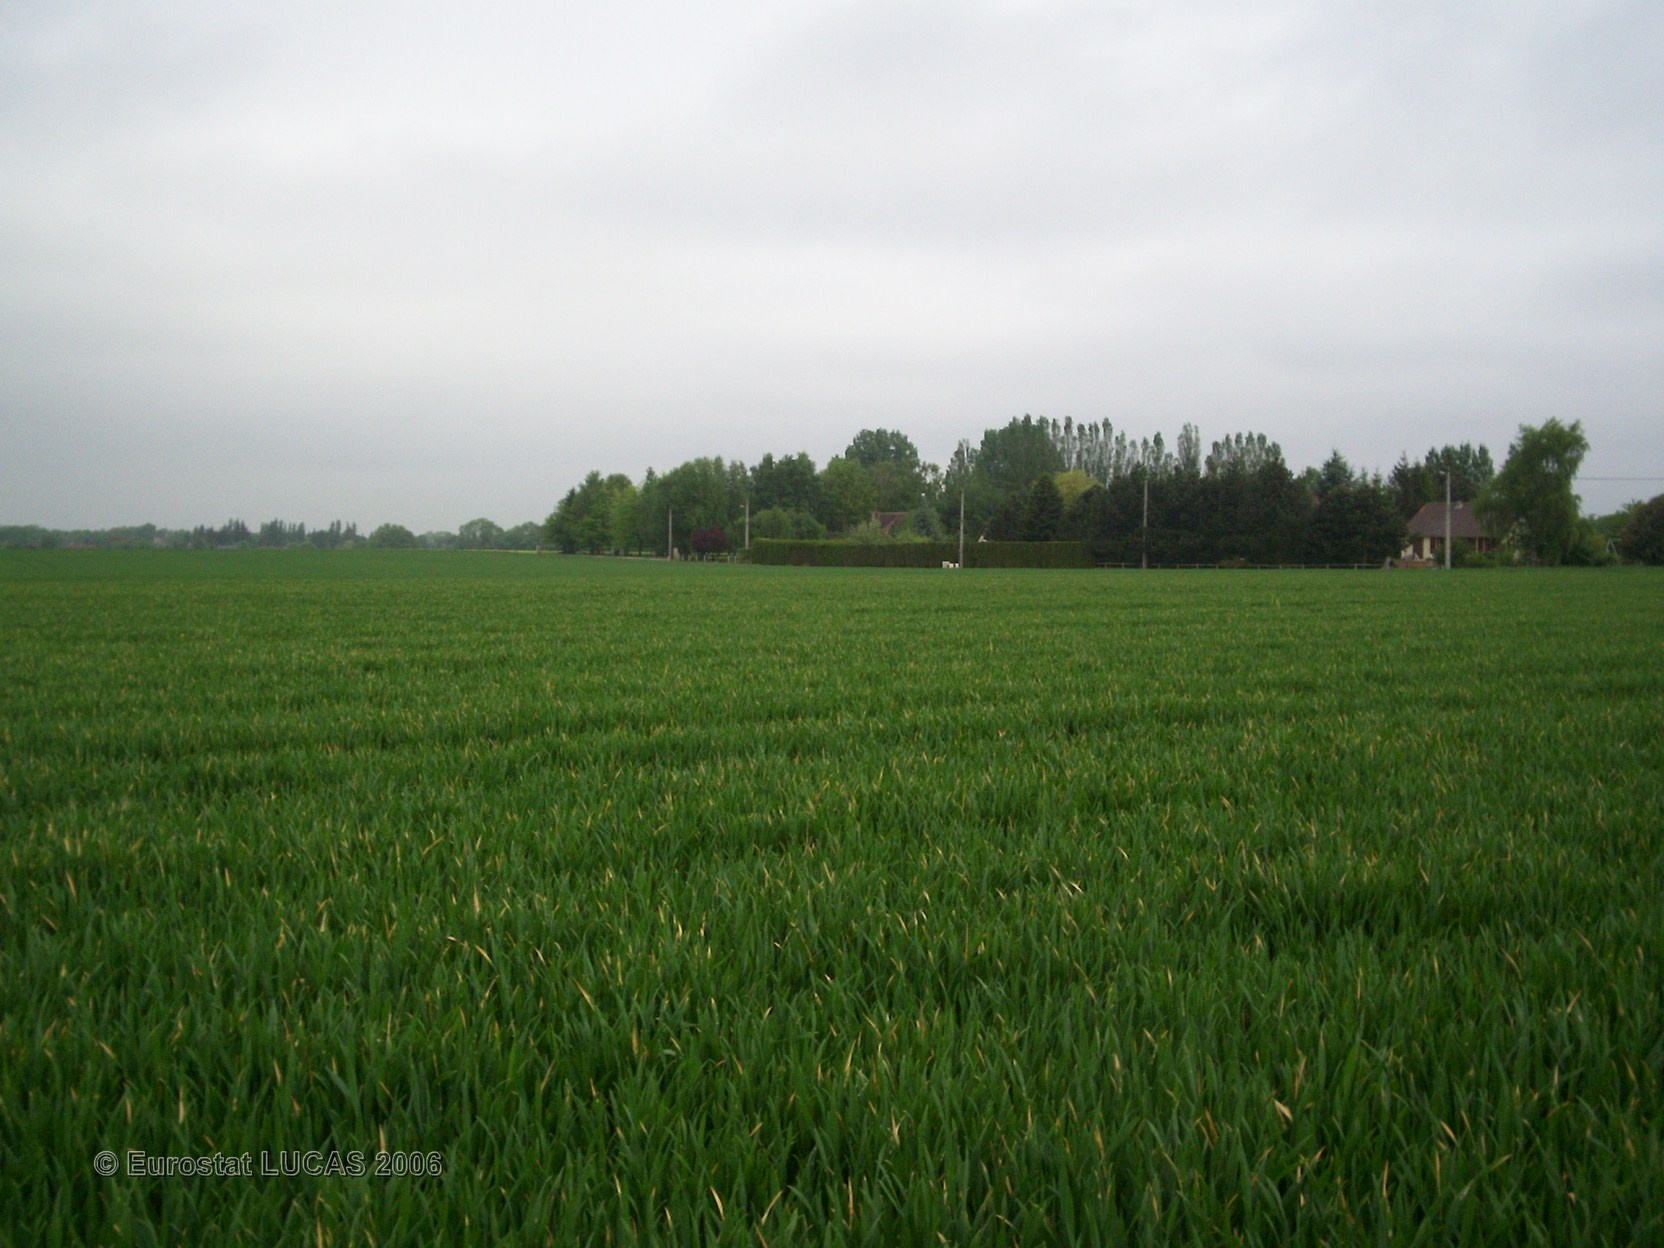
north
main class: Cropland
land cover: Common wheat
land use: Agriculture (excluding fallow land and kitchen gardens)
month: May
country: FR
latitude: 49.2648
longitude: 0.9768
